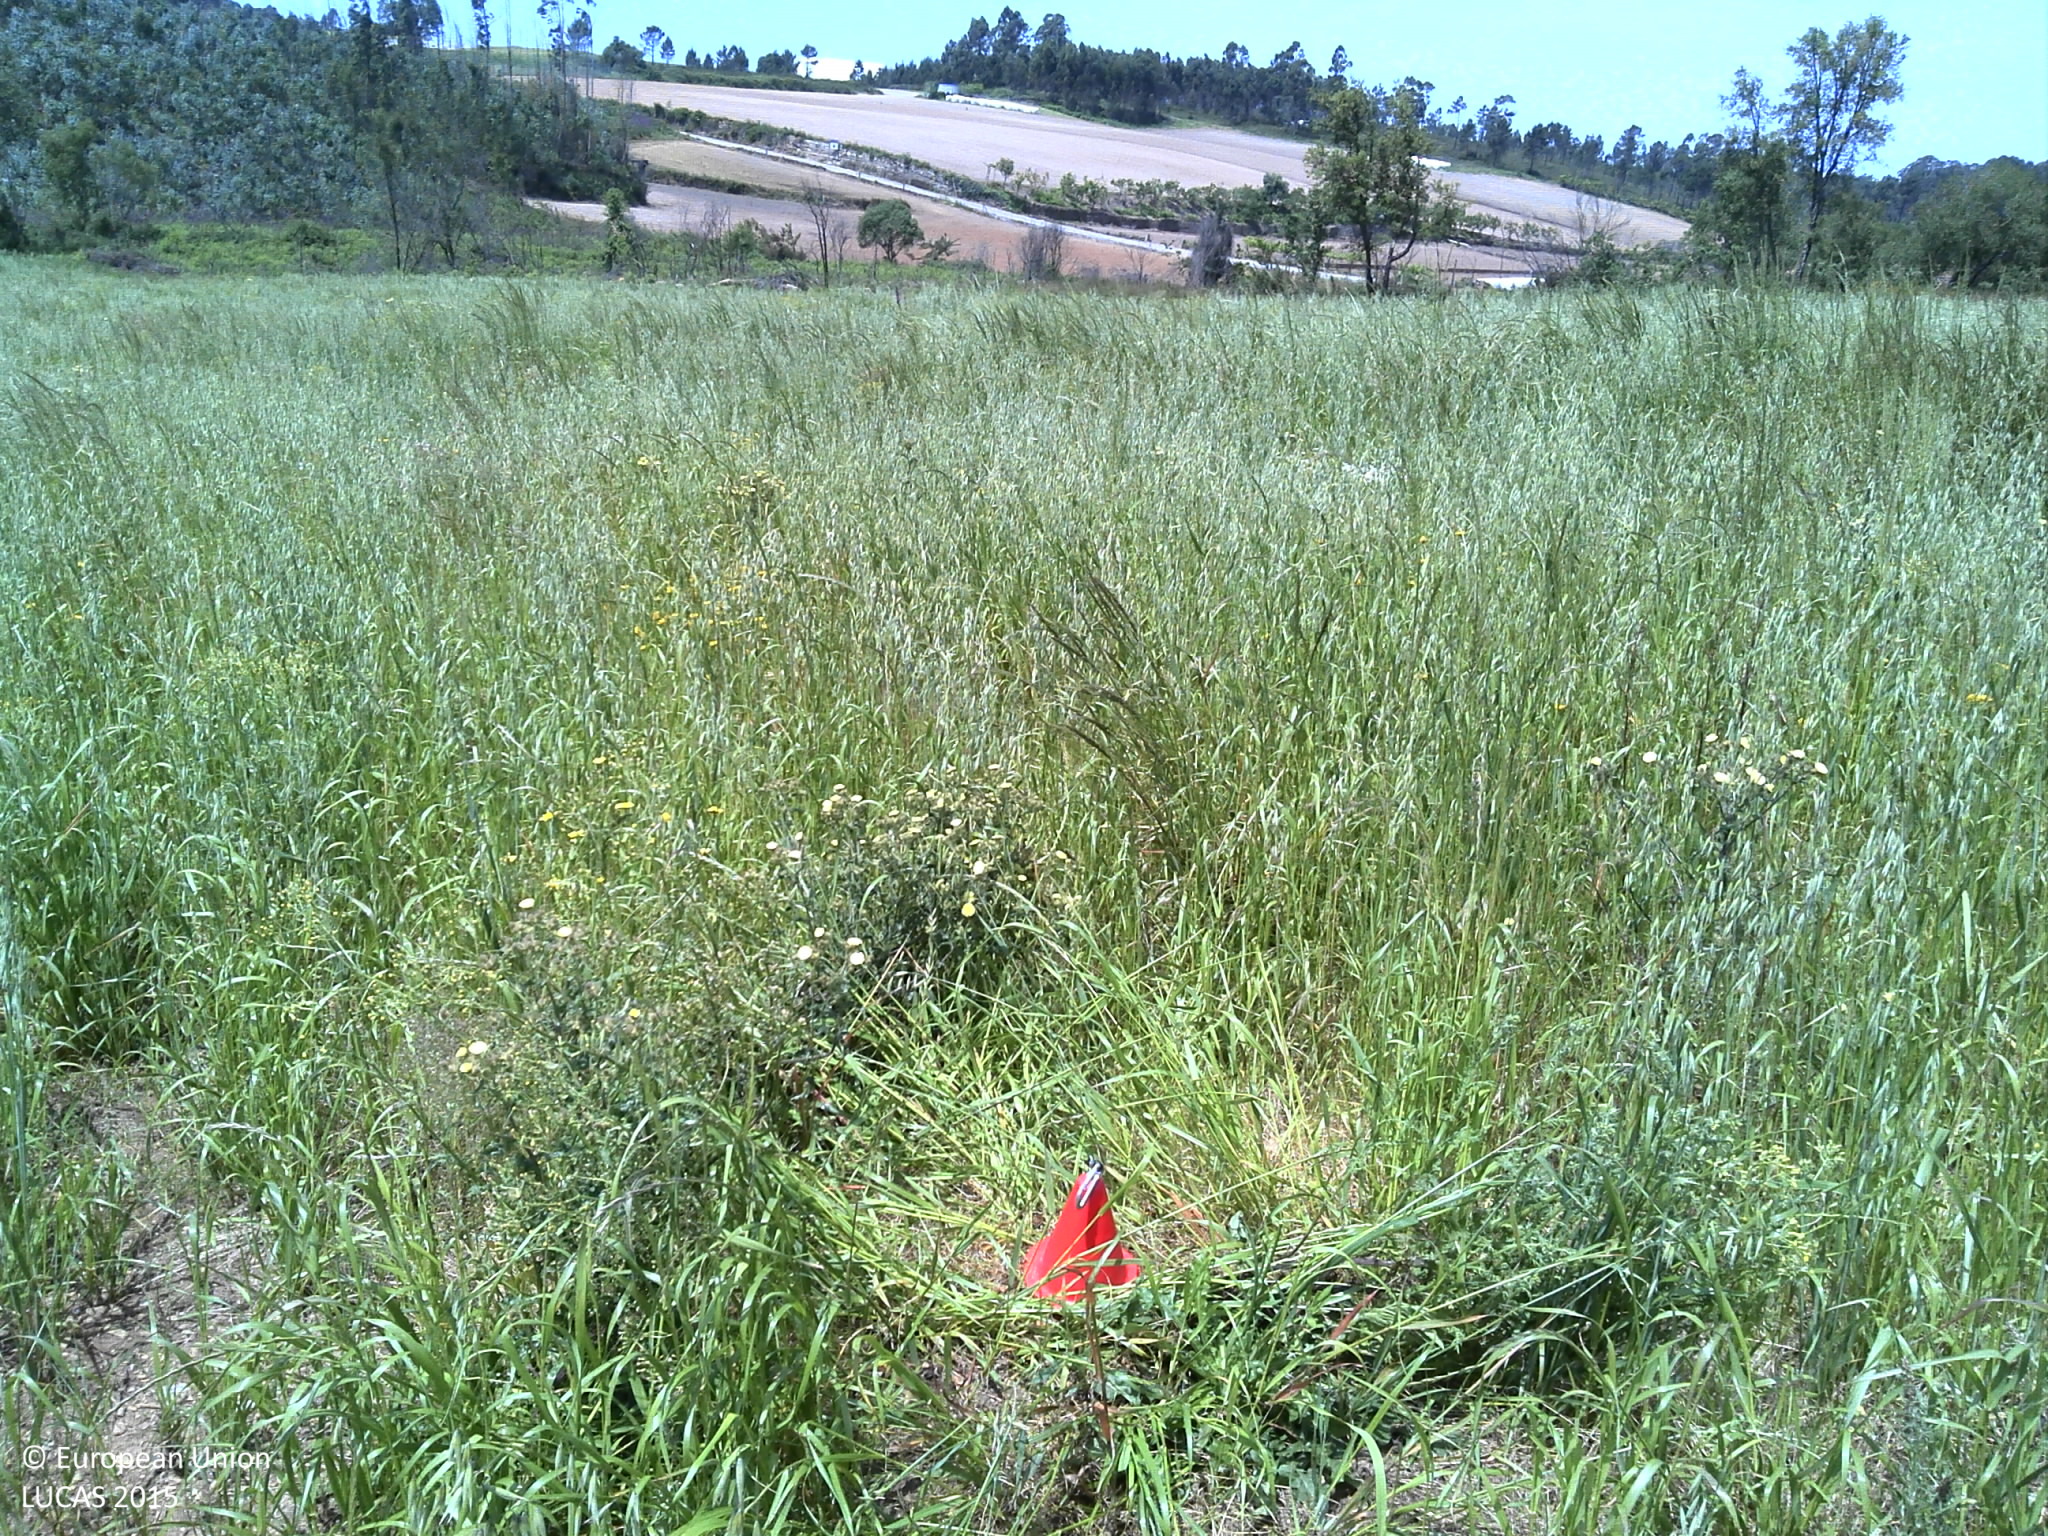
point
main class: Cropland
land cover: Mixed cereals for fodder
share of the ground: > 75 %
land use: Agriculture (excluding fallow land and kitchen gardens)
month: May
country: PT
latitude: 41.4483
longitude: -8.7019
